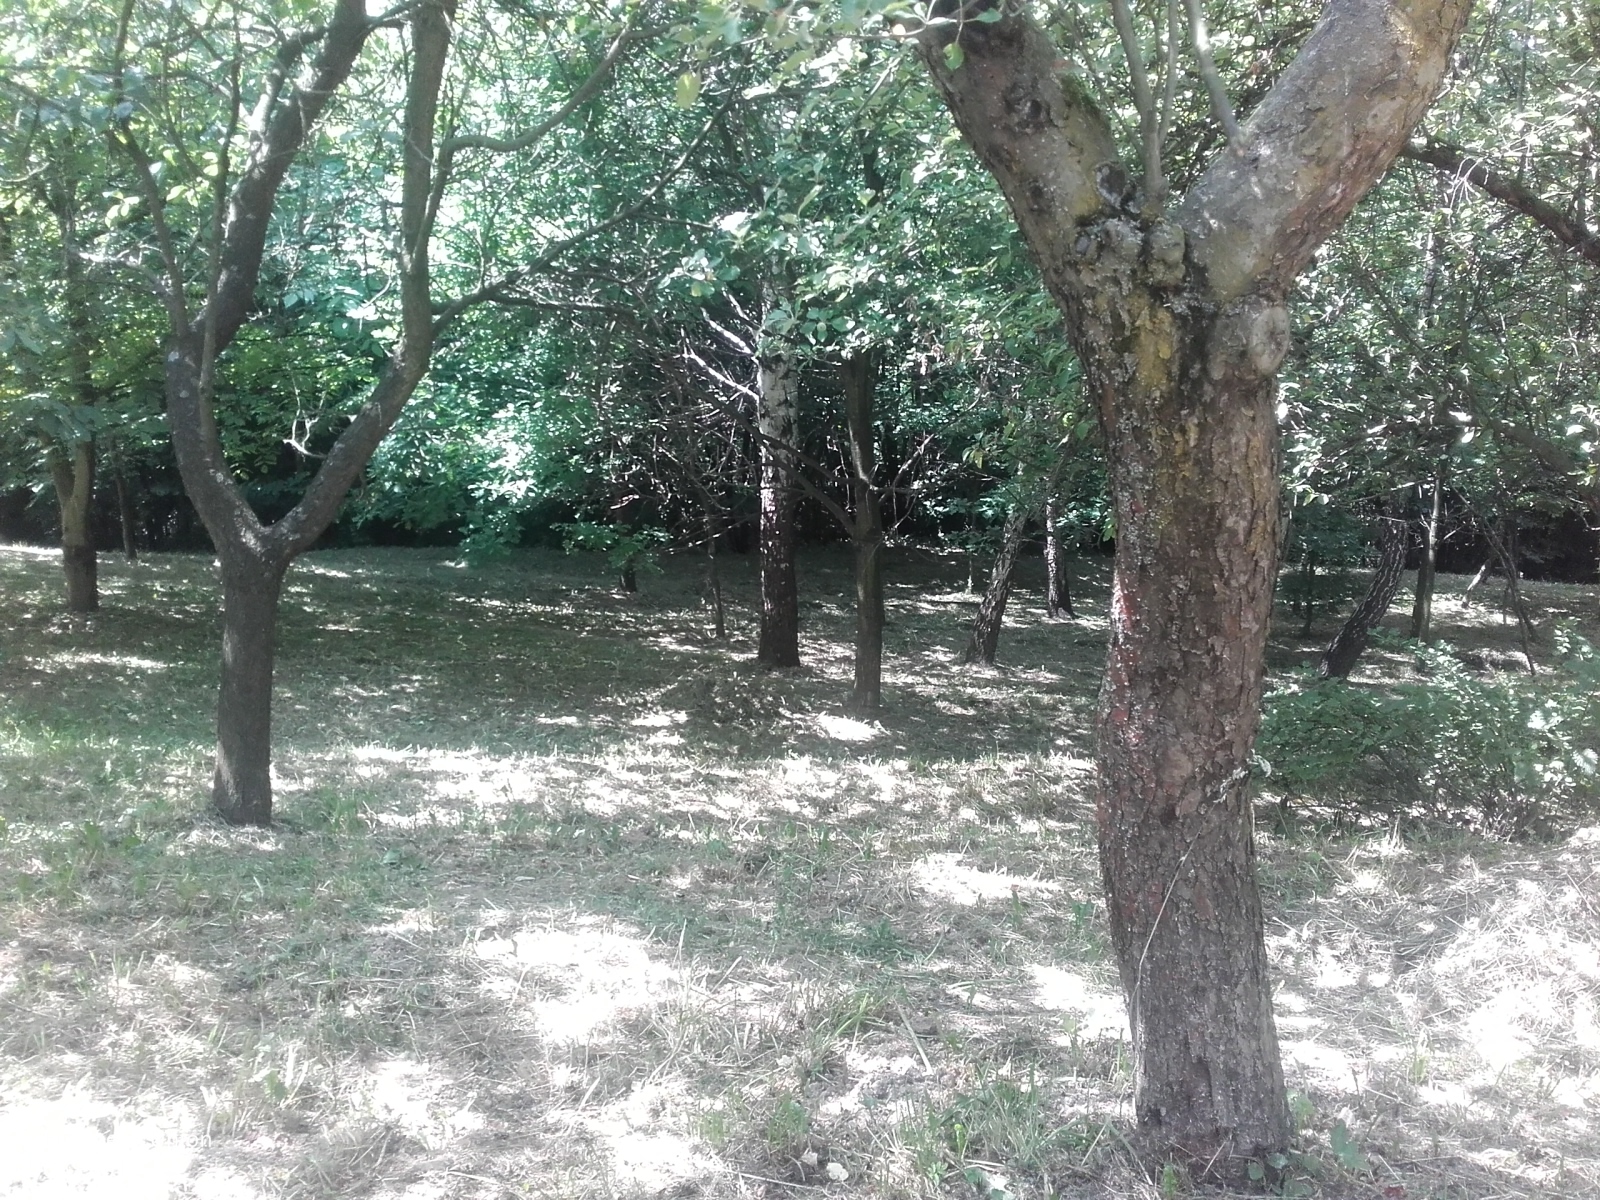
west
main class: Cropland
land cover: Apple fruit
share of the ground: > 75 %
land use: Kitchen garden
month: June
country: CZ
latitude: 49.5762
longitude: 18.7468
